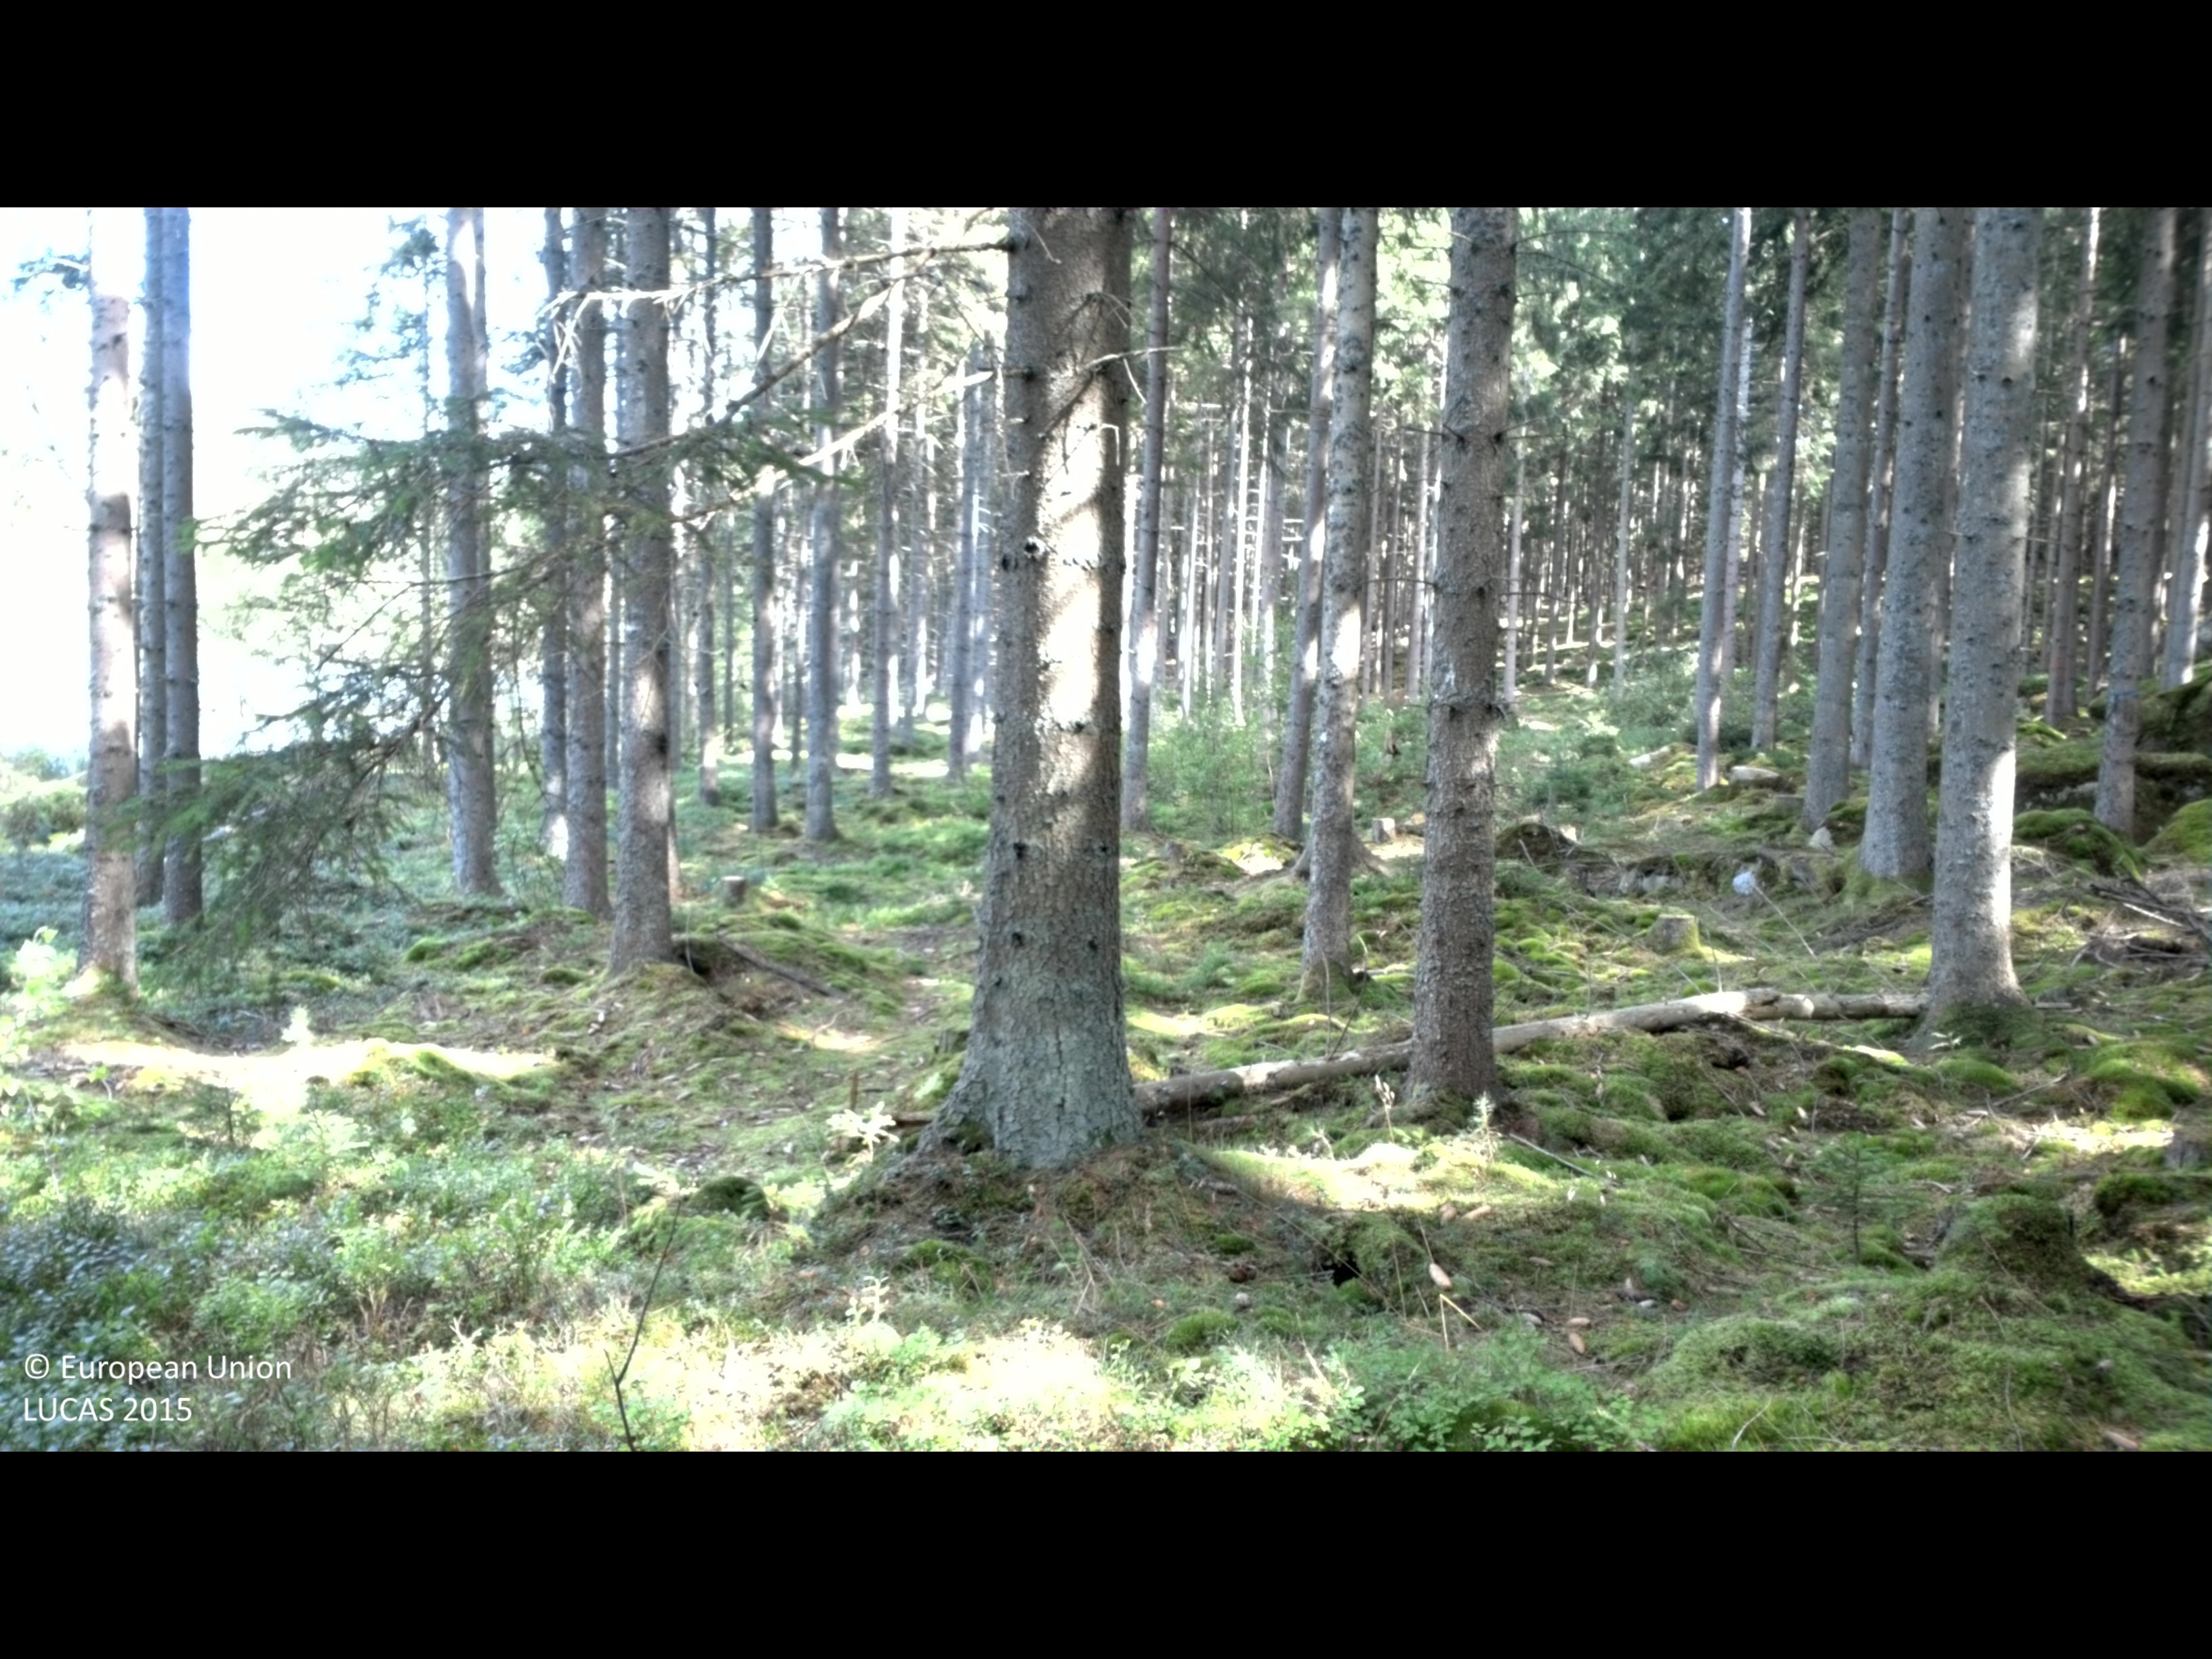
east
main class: Woodland
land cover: Spruce dominated coniferous woodland
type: boreal forest
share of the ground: > 75 %
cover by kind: coniferous forest trees 80 %, lichens and mosses 10 %, shrubs 5 %, herbaceous plants 5 %
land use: Forestry
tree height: > 5 m
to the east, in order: Spruce dominated coniferous woodland; Spruce dominated mixed woodland; Spruce dominated coniferous woodland
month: August
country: SE
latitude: 56.2965
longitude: 14.2797
